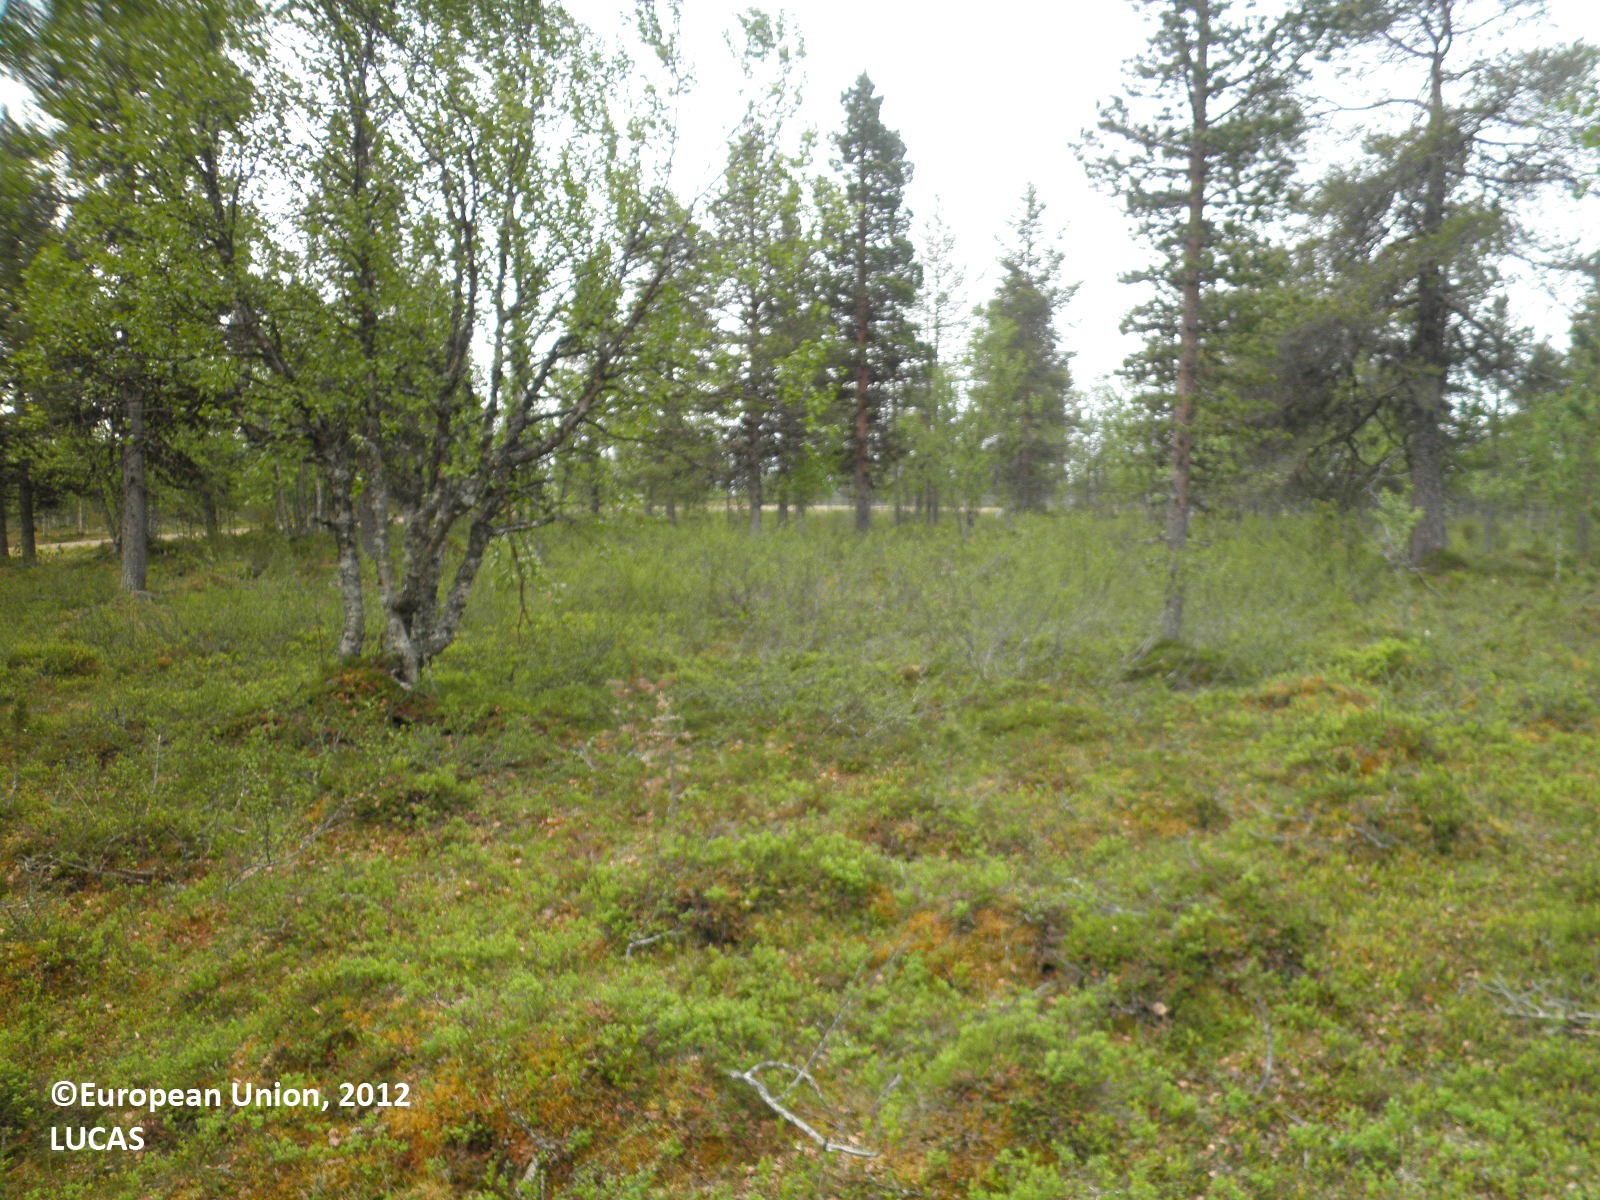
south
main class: Woodland
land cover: Pine dominated mixed woodland
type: boreal forest
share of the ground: 50 - 75 %
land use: Forestry
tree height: > 5 m
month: July
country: FI
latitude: 68.4001
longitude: 25.6406
